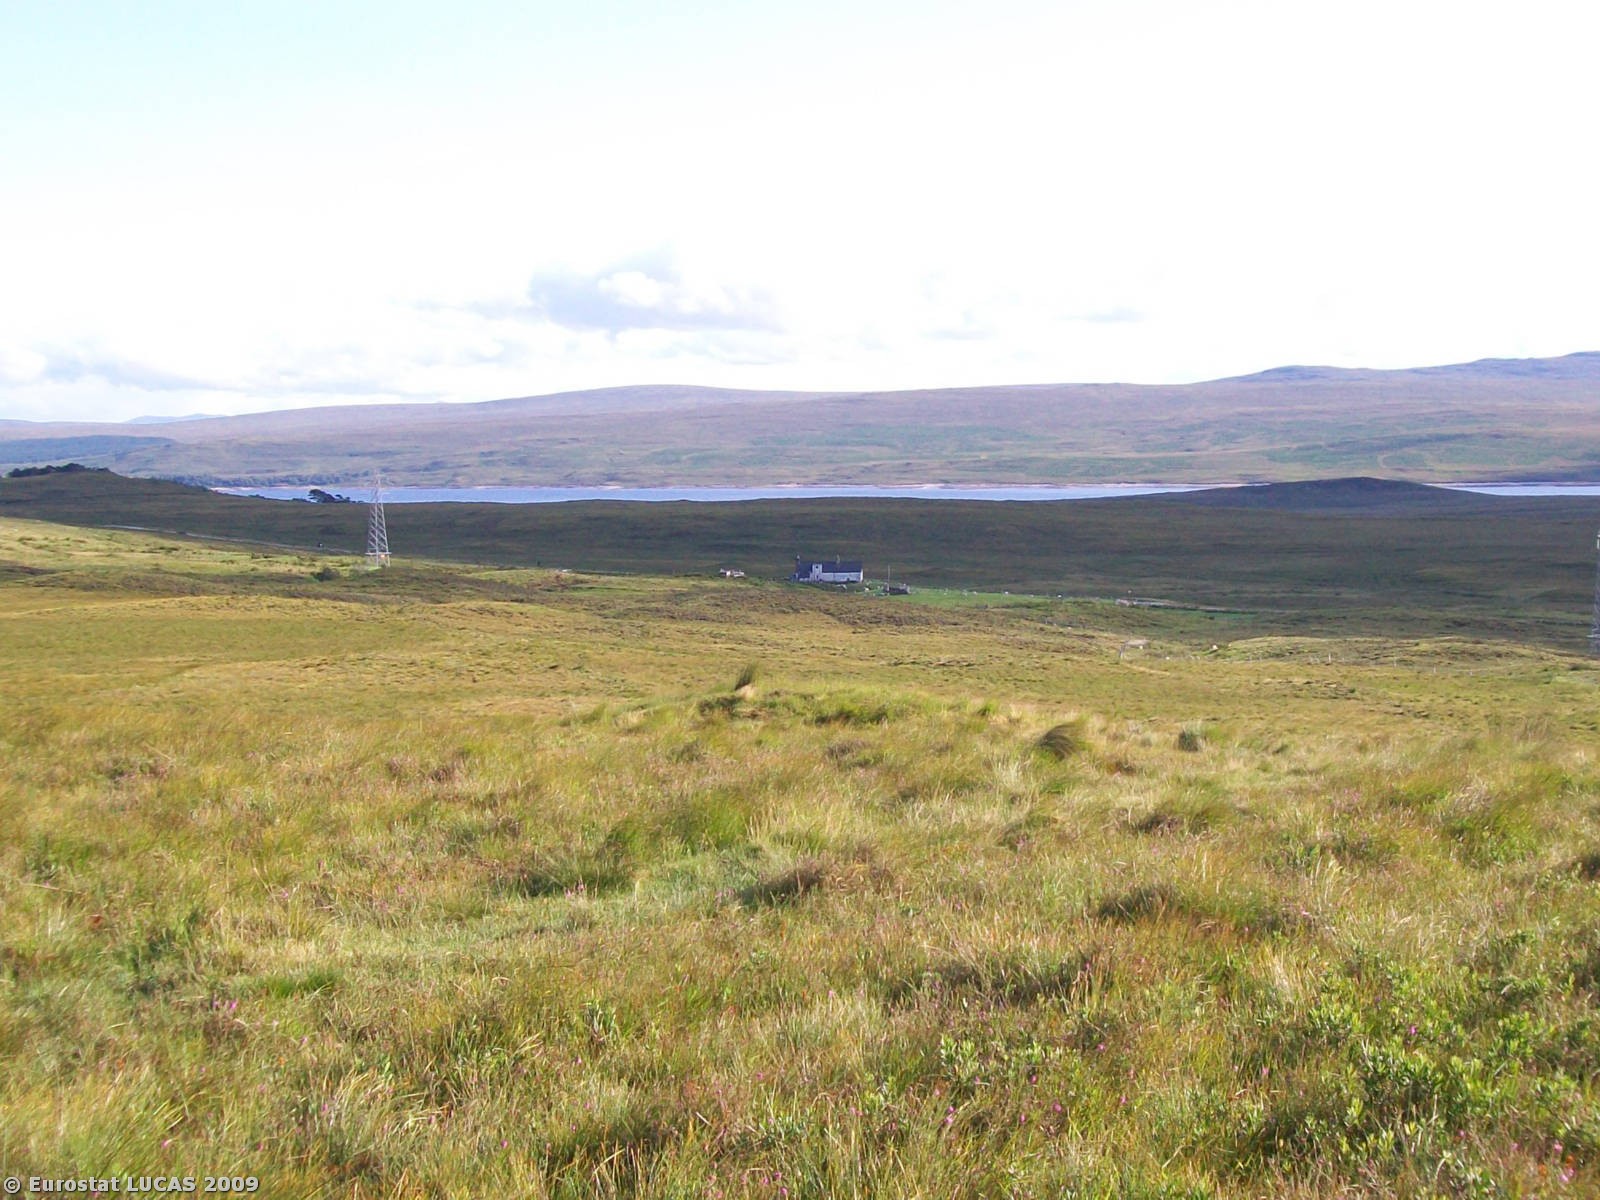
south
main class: Shrubland
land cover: Shrubland without tree cover
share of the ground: > 75 %
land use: Agriculture (excluding fallow land and kitchen gardens)
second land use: Forestry
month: August
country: GB
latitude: 58.1372
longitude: -4.5419
